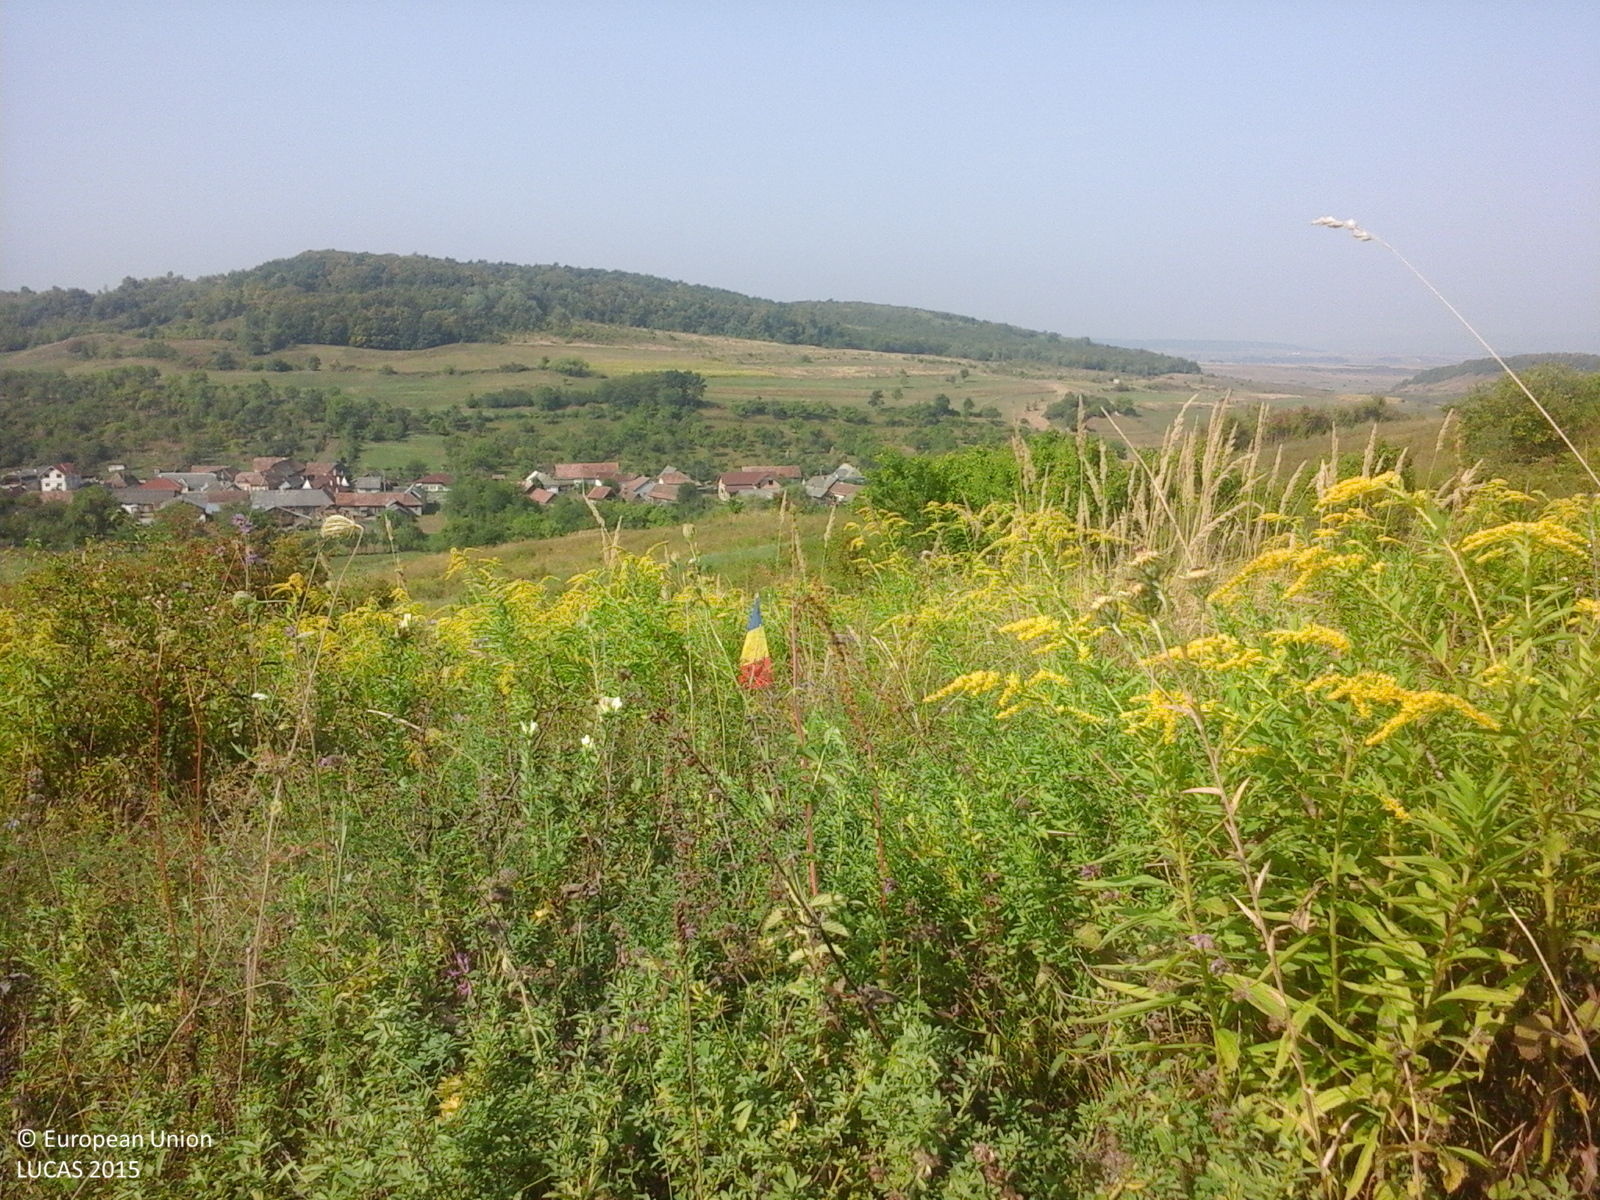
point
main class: Grassland
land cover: Spontaneously vegetated surfaces
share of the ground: > 75 %
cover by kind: herbaceous plants 100 %
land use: Fallow land
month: September
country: RO
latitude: 47.1478
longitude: 24.3705
